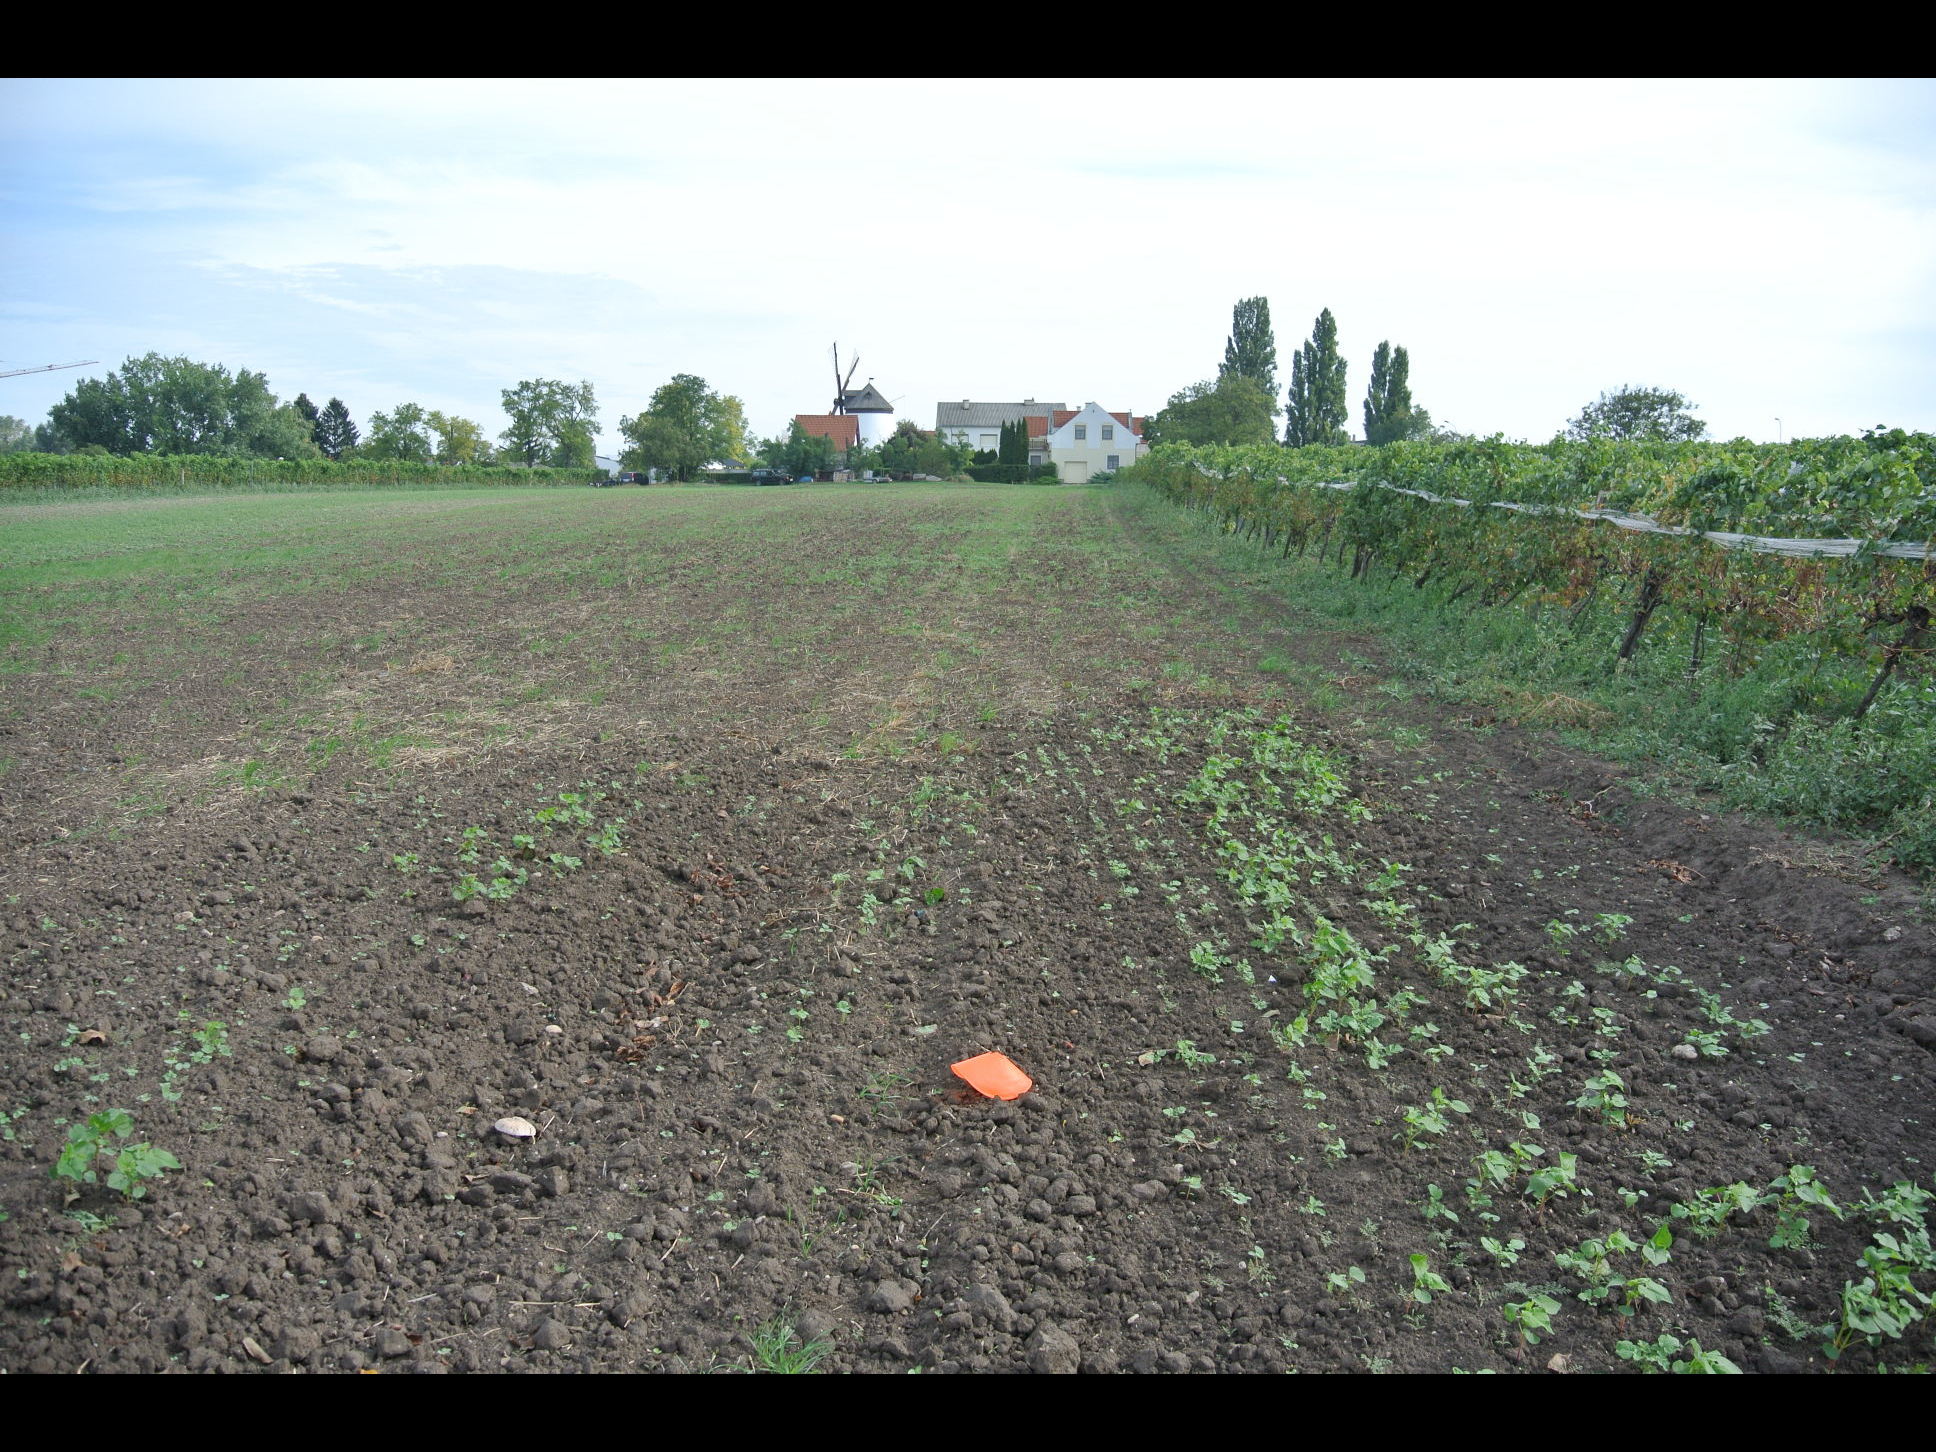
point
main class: Cropland
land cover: Durum wheat
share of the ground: > 75 %
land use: Agriculture (excluding fallow land and kitchen gardens)
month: July
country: AT
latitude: 47.8488
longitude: 16.8348
